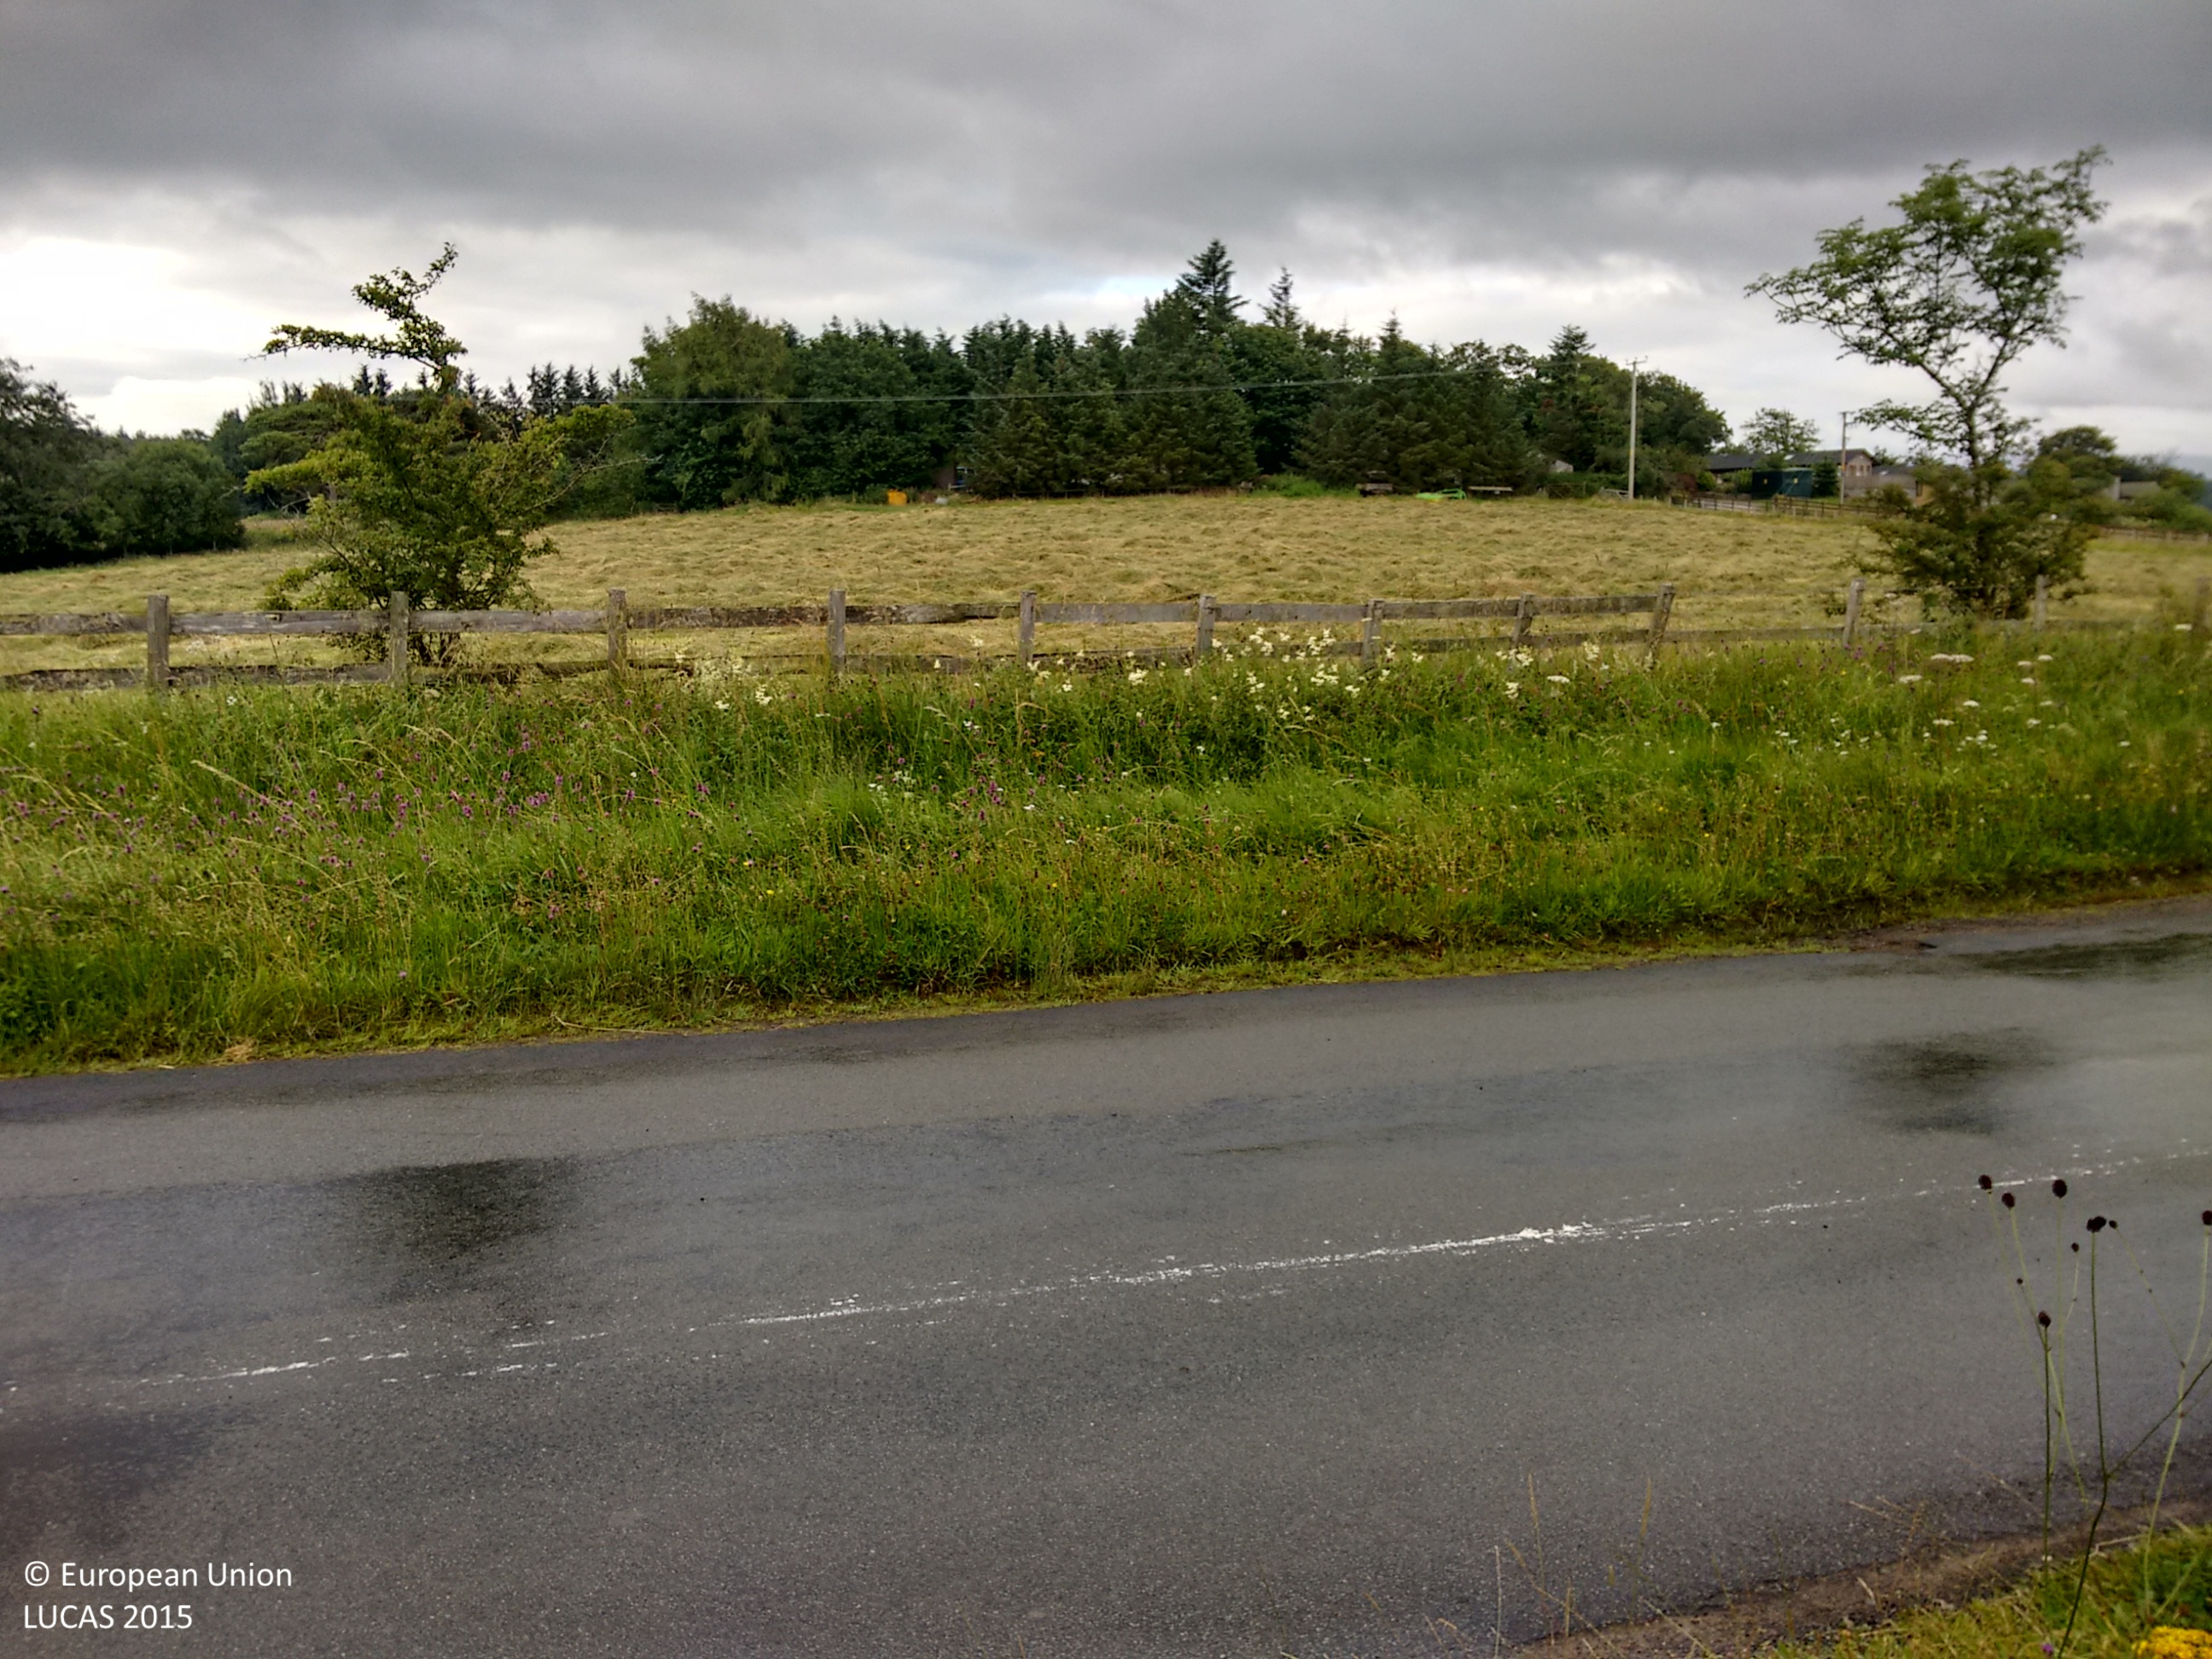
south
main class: Grassland
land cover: Grassland with sparse tree/shrub cover
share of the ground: > 75 %
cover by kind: herbaceous plants 95 %, broadleaved forest trees 5 %
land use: Agriculture (excluding fallow land and kitchen gardens)
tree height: > 5 m
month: August
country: GB
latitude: 54.7088
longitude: -2.9375
